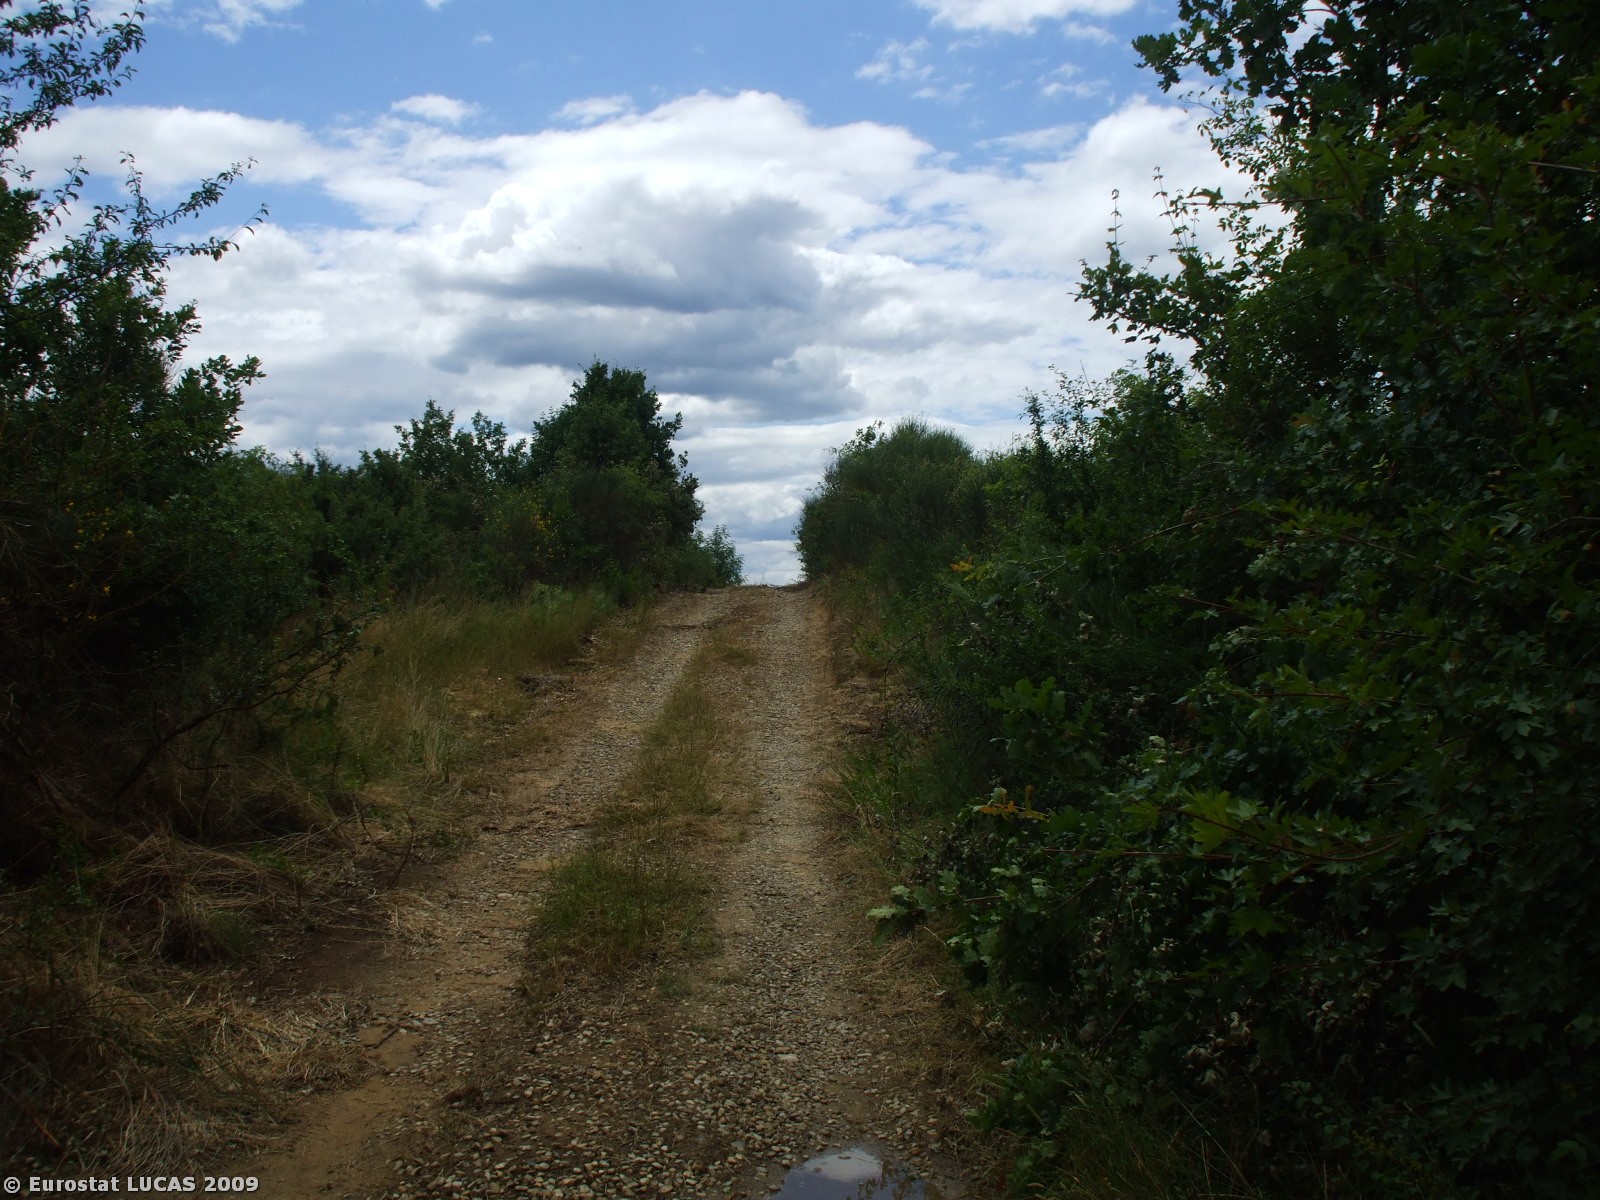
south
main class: Shrubland
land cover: Shrubland with sparse tree cover
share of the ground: > 75 %
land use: Unused
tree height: > 5 m
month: June
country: IT
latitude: 43.5251
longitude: 11.6658
